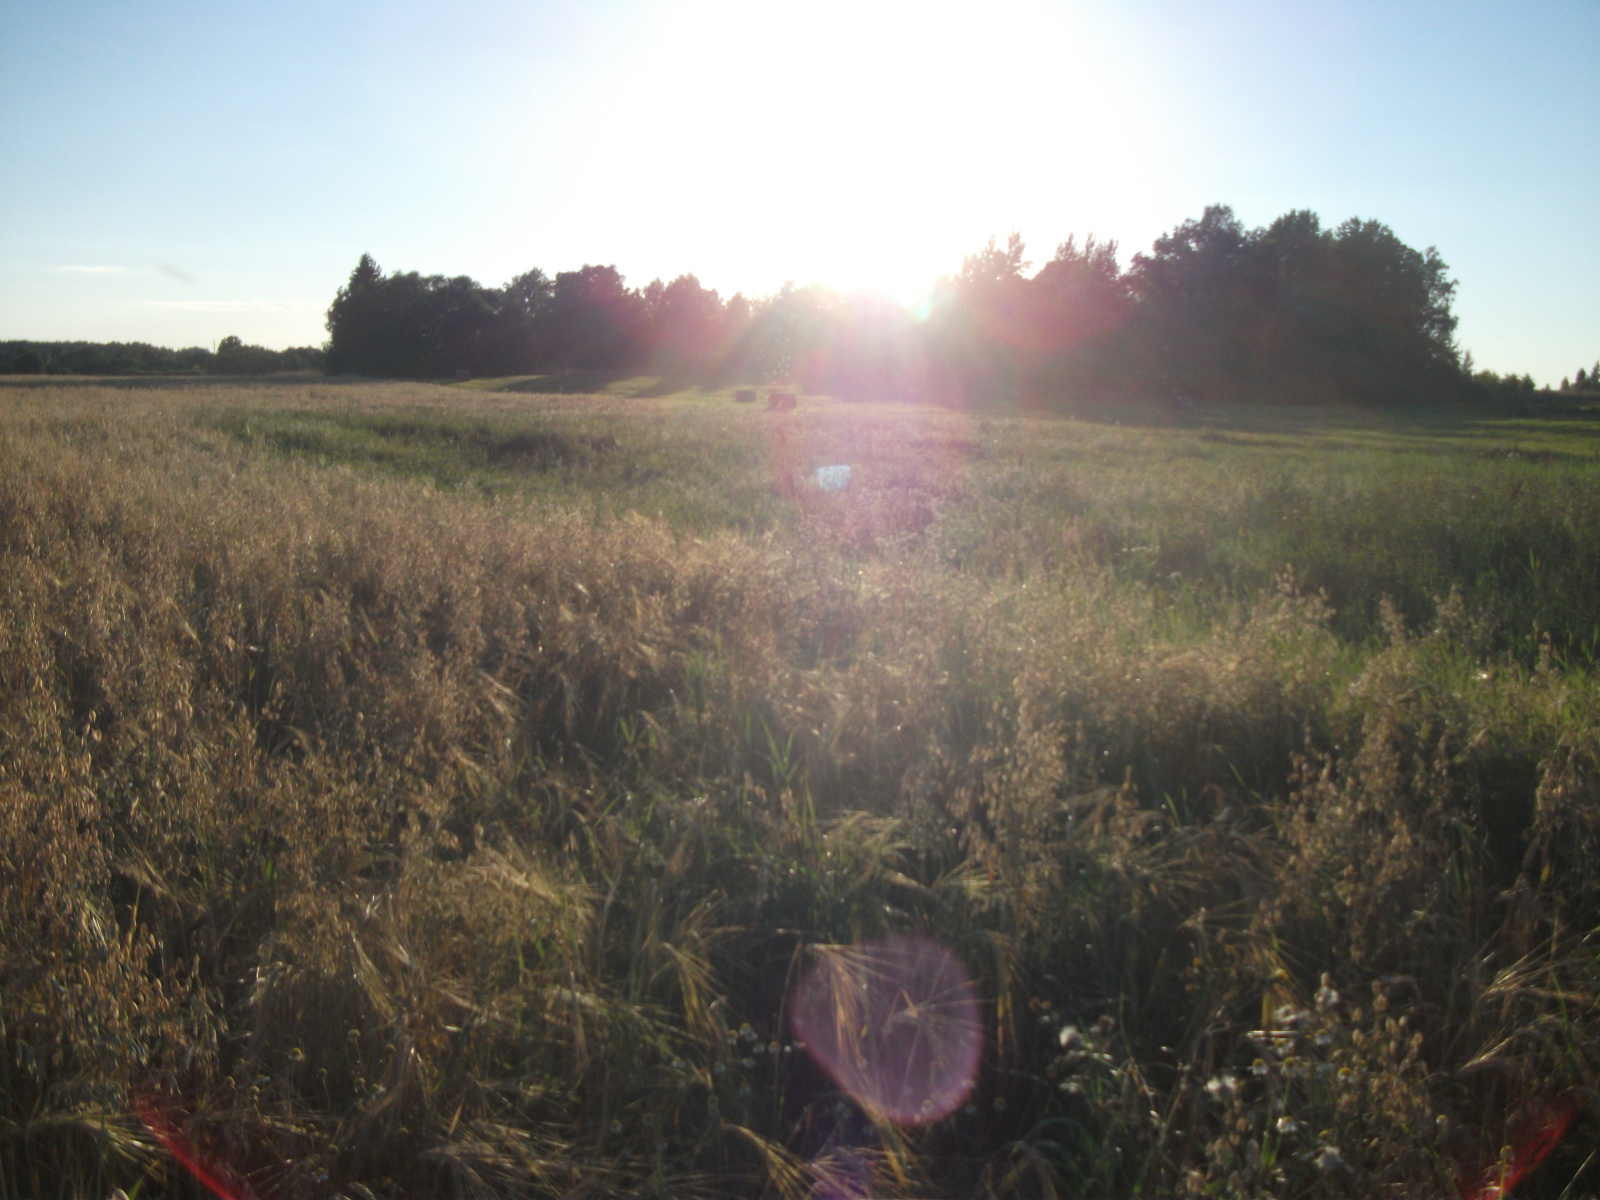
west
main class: Cropland
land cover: Mixed cereals for fodder
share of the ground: 50 - 75 %
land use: Agriculture (excluding fallow land and kitchen gardens)
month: August
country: LV
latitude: 56.3397
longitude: 26.3704
